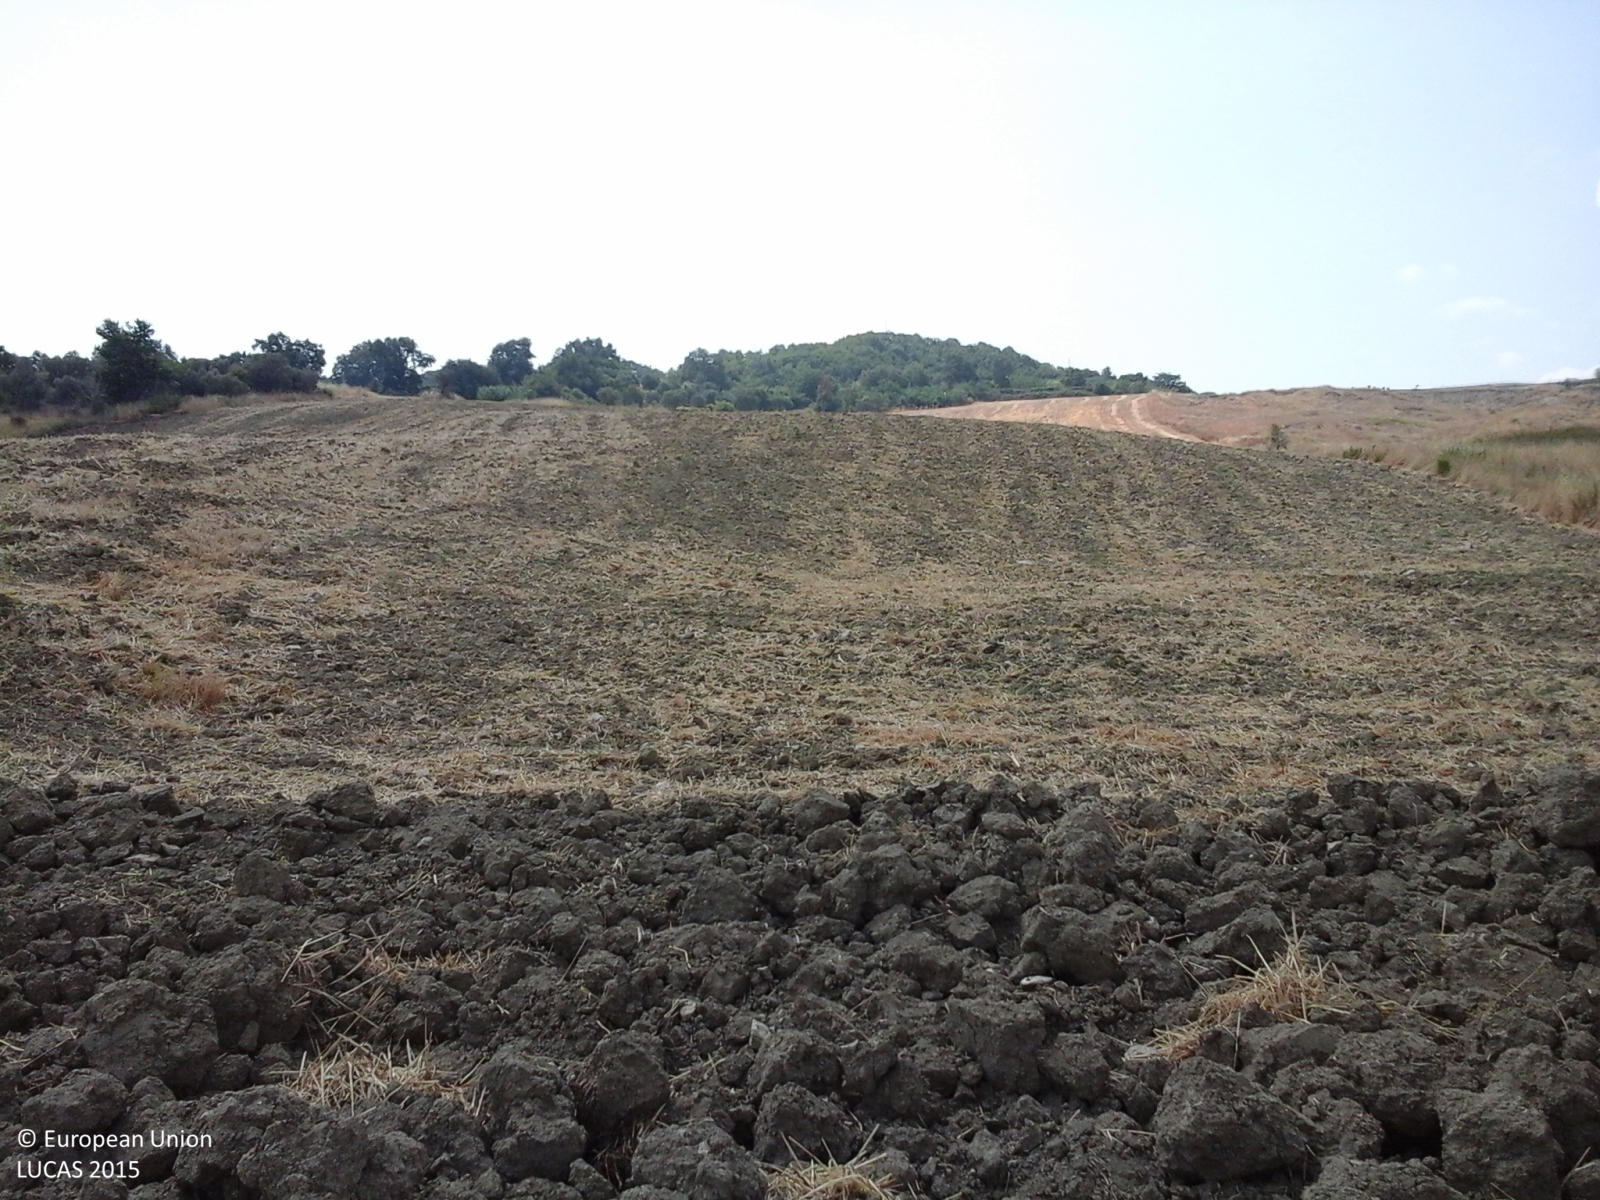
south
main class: Cropland
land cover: Durum wheat
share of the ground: > 75 %
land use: Agriculture (excluding fallow land and kitchen gardens)
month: August
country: IT
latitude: 41.9467
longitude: 14.7257
